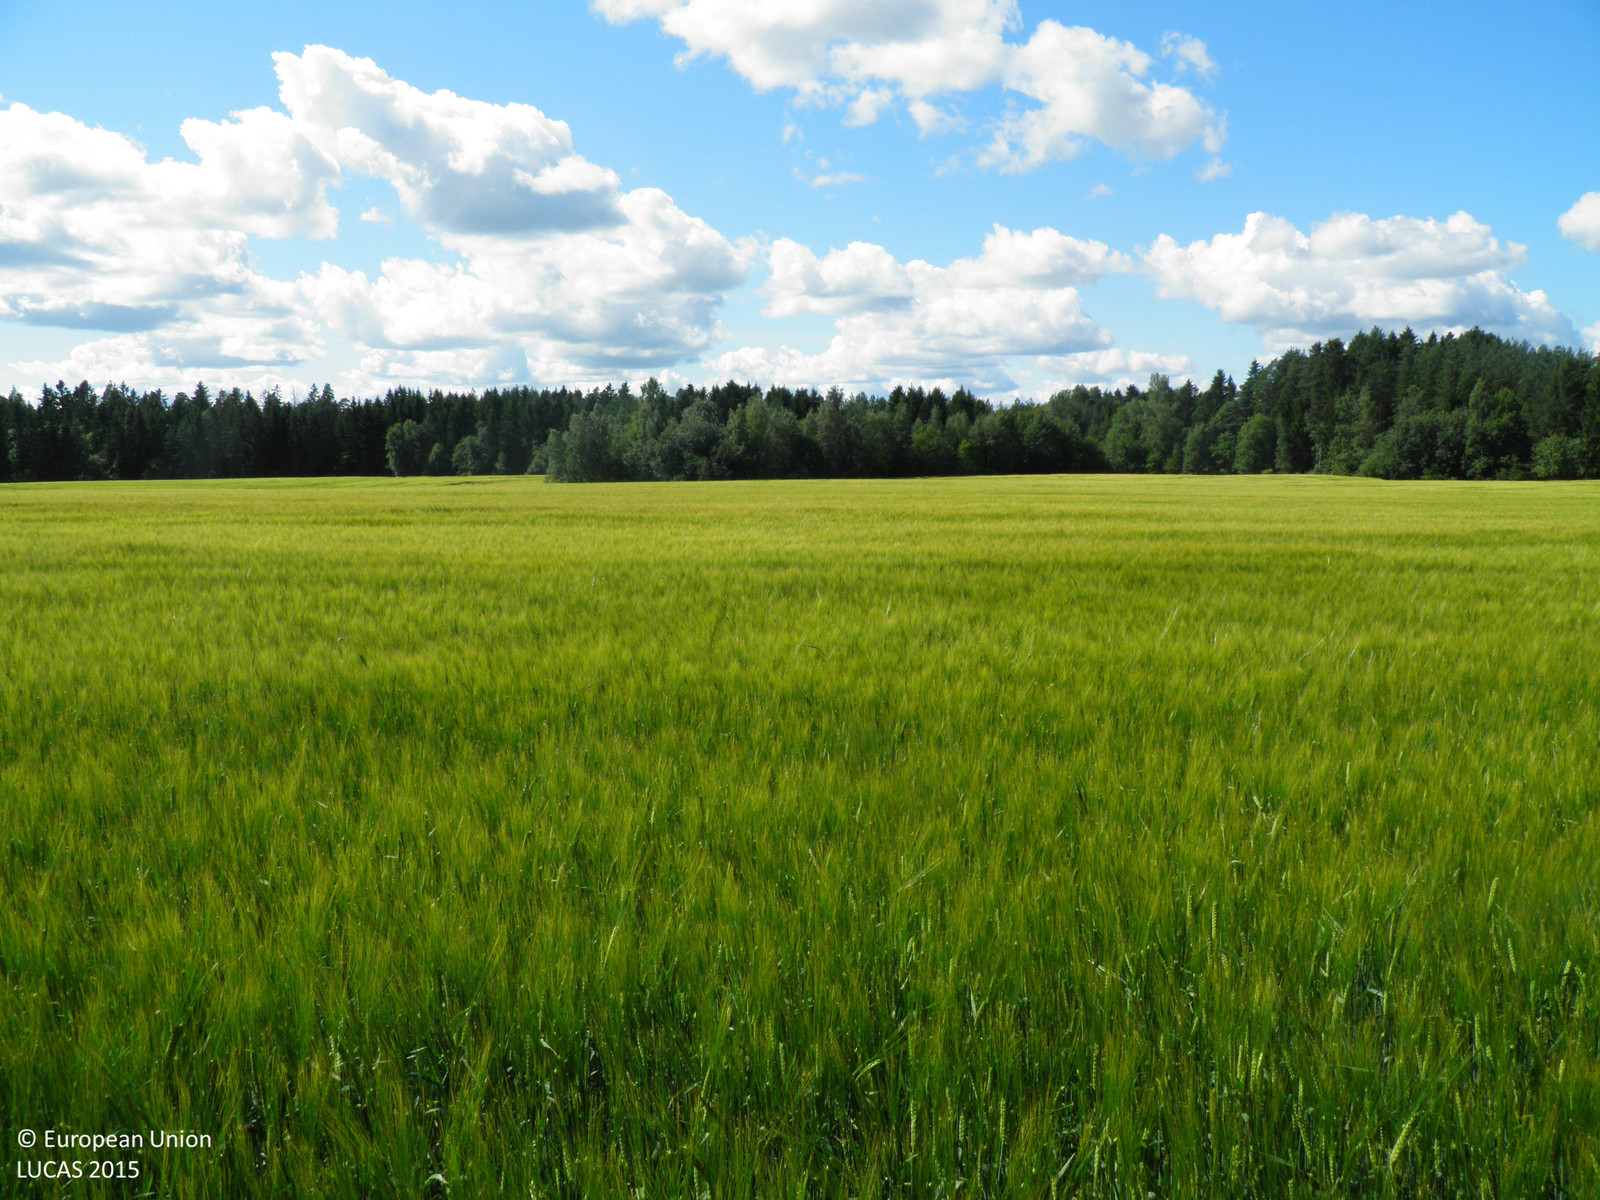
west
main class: Cropland
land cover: Barley
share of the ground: > 75 %
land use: Agriculture (excluding fallow land and kitchen gardens)
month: August
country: FI
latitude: 60.9381
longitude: 22.8997
